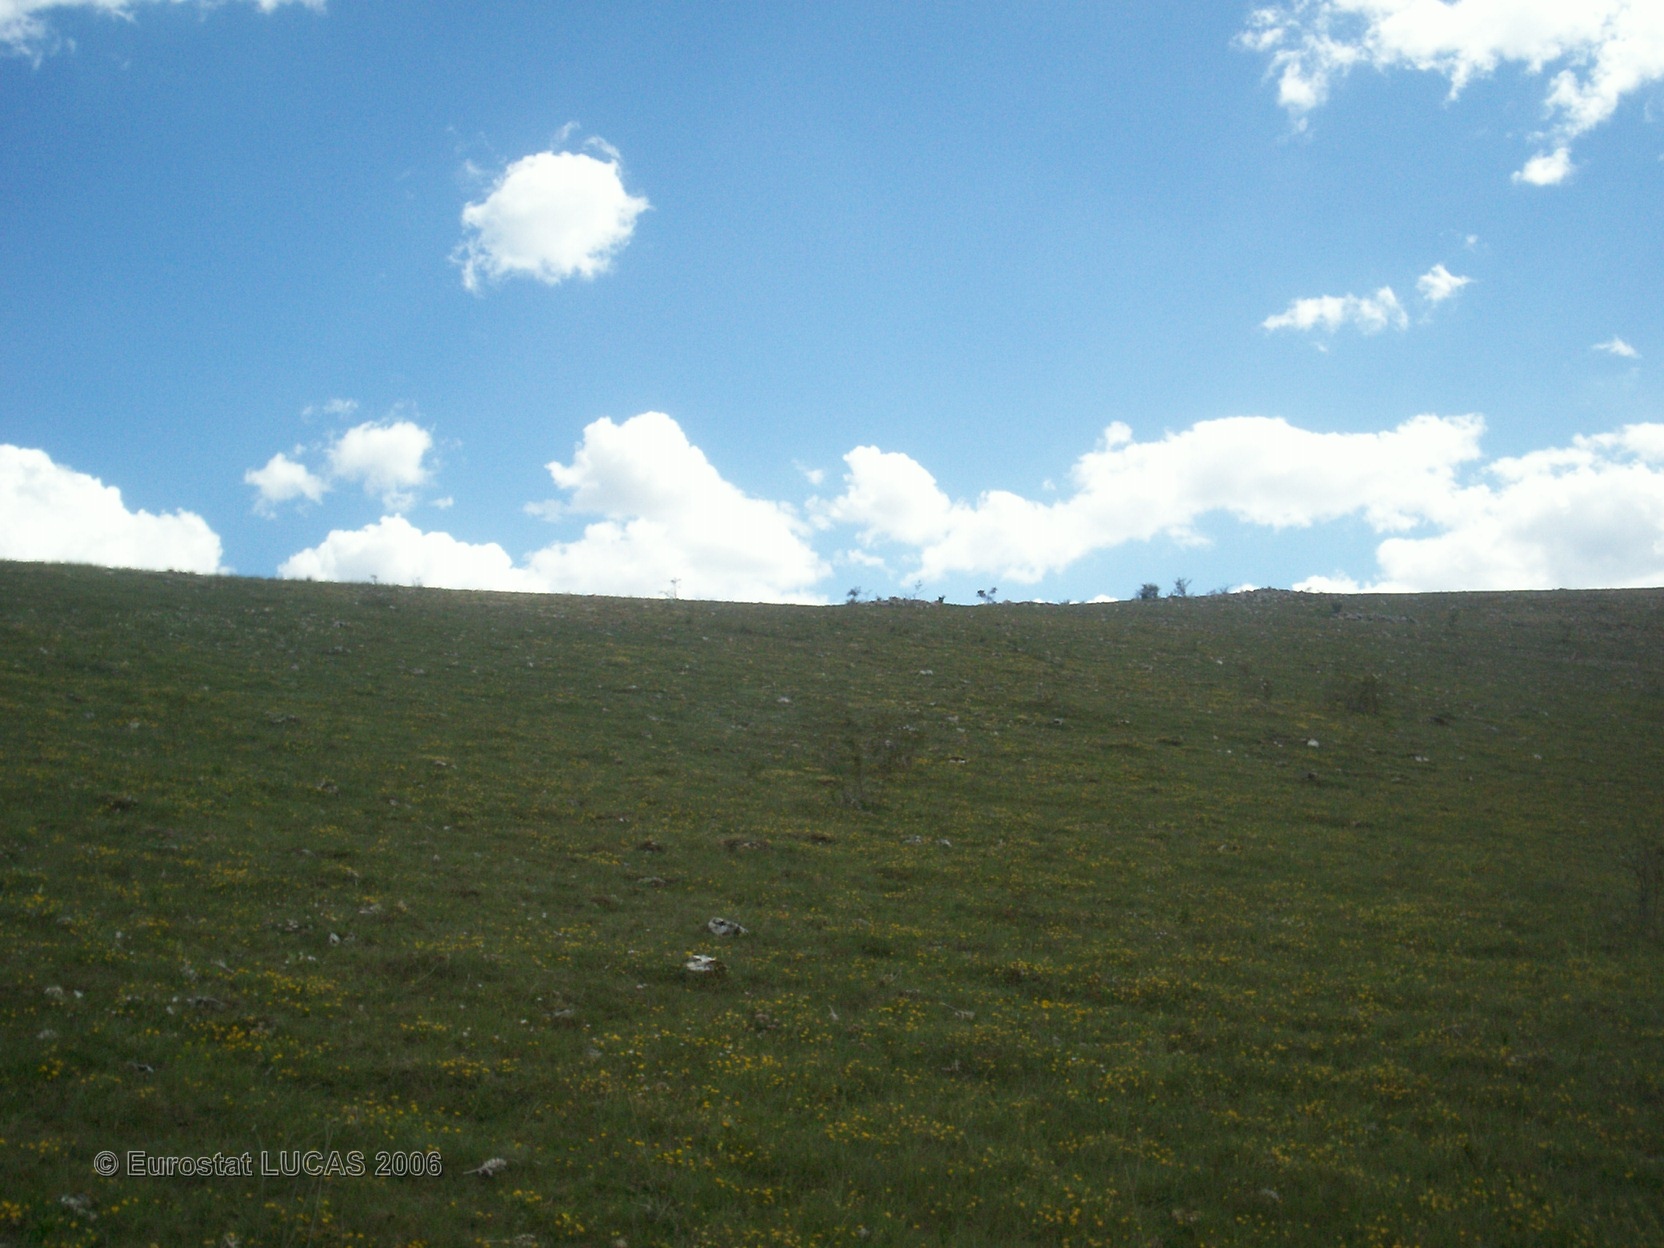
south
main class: Grassland
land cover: Grassland without tree/shrub cover
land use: Agriculture (excluding fallow land and kitchen gardens)
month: June
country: FR
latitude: 44.2329
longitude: 3.4331
